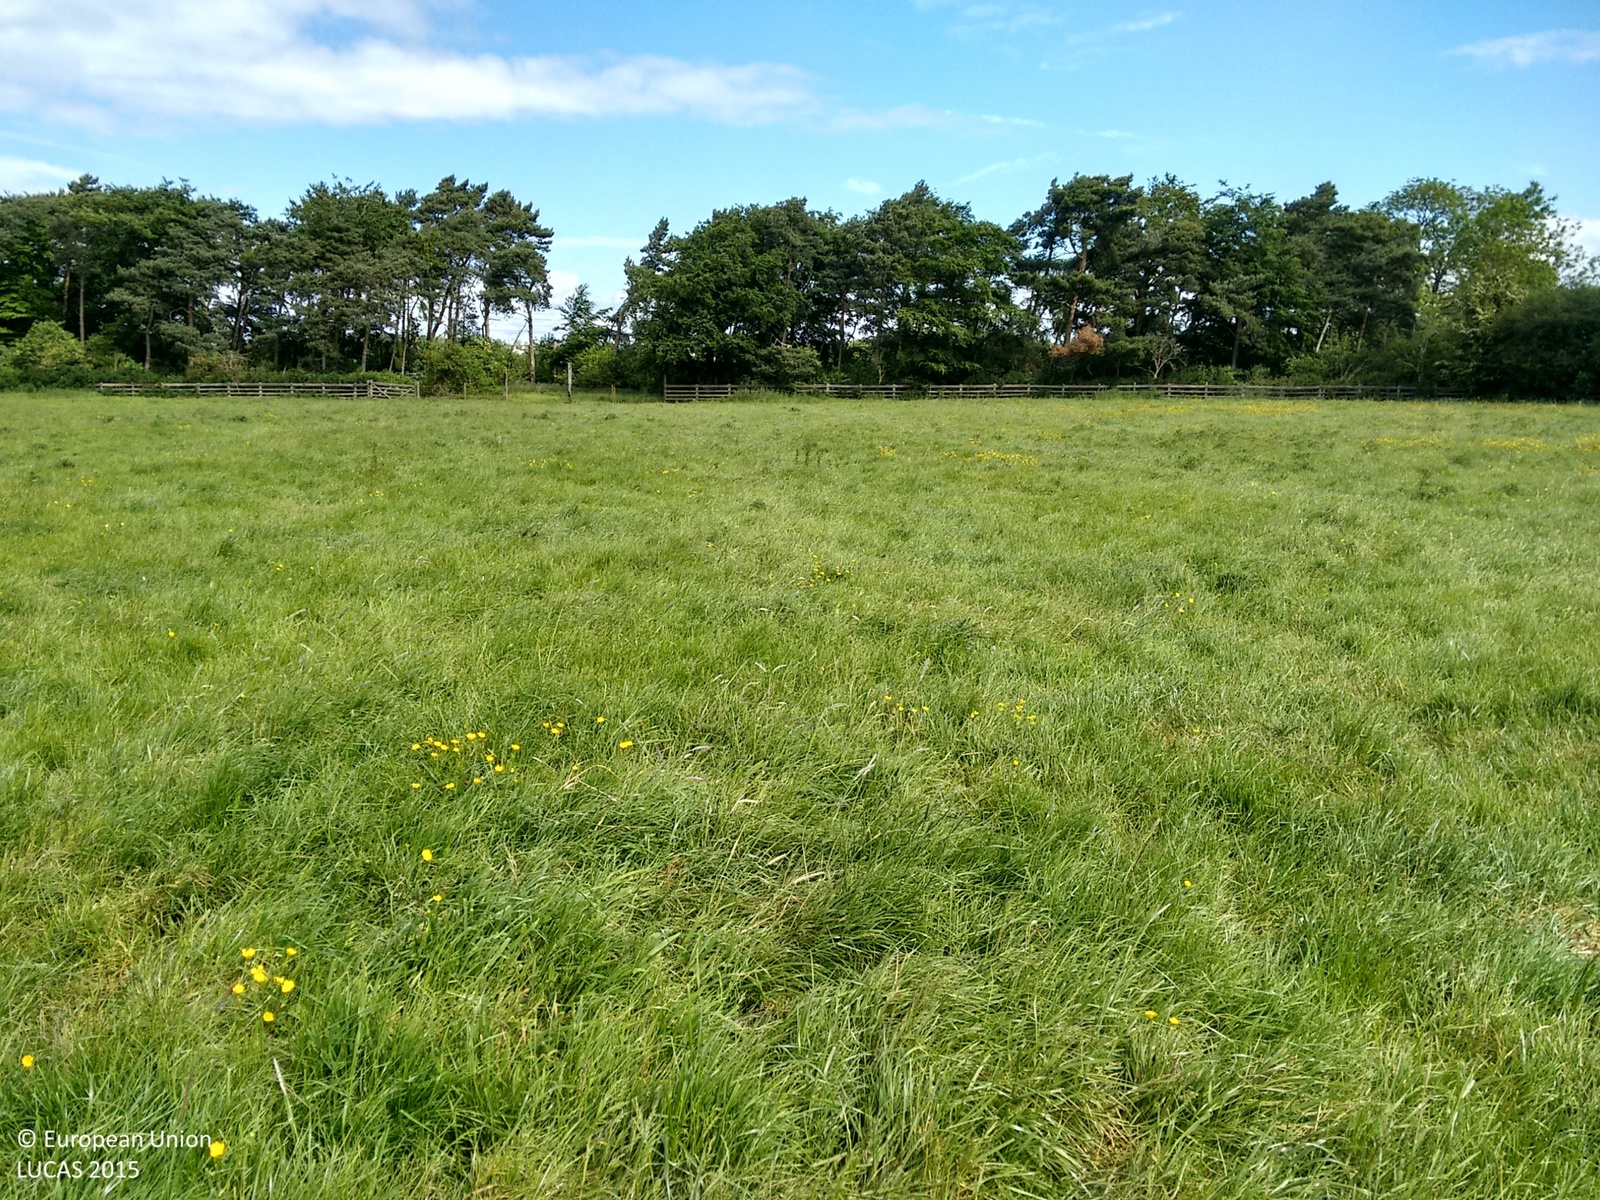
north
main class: Grassland
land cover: Grassland without tree/shrub cover
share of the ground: > 75 %
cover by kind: herbaceous plants 100 %
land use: Agriculture (excluding fallow land and kitchen gardens)
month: June
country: GB
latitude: 52.5182
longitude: -1.3819
